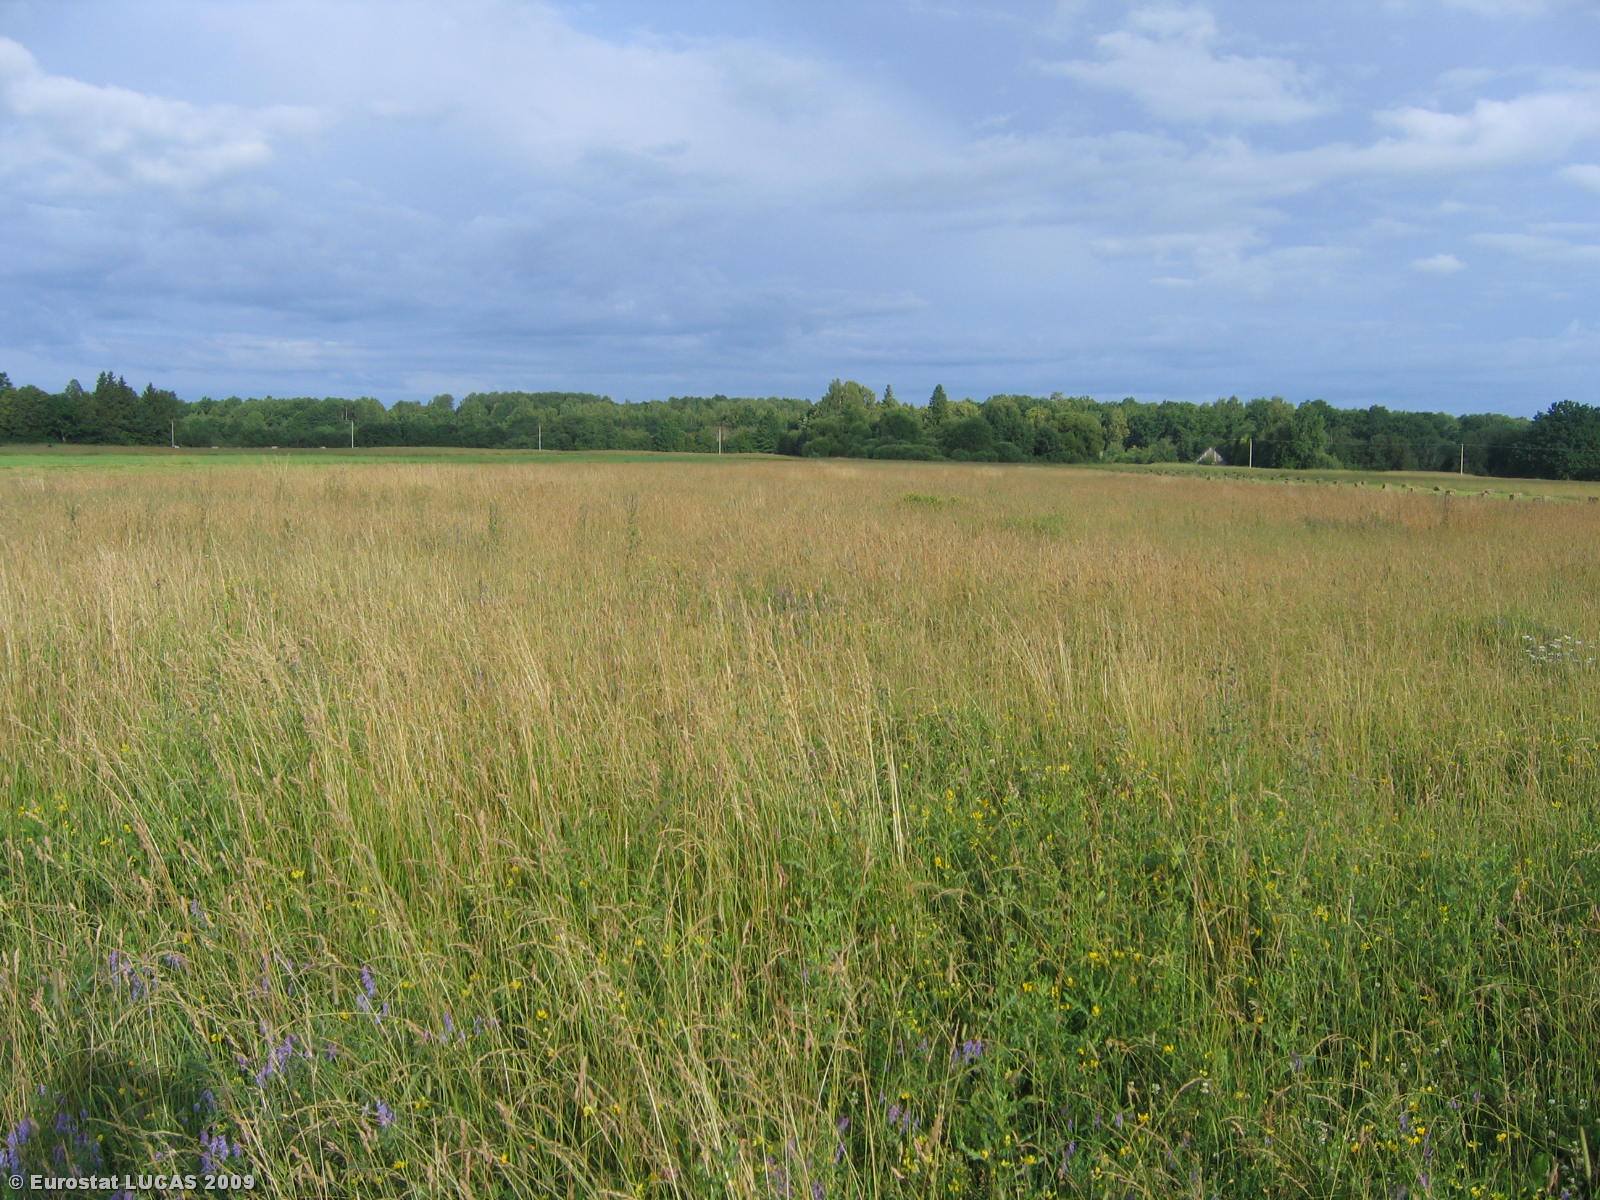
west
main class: Grassland
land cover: Grassland without tree/shrub cover
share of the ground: > 75 %
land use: Agriculture (excluding fallow land and kitchen gardens)
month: July
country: LT
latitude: 55.3677
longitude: 22.7350
